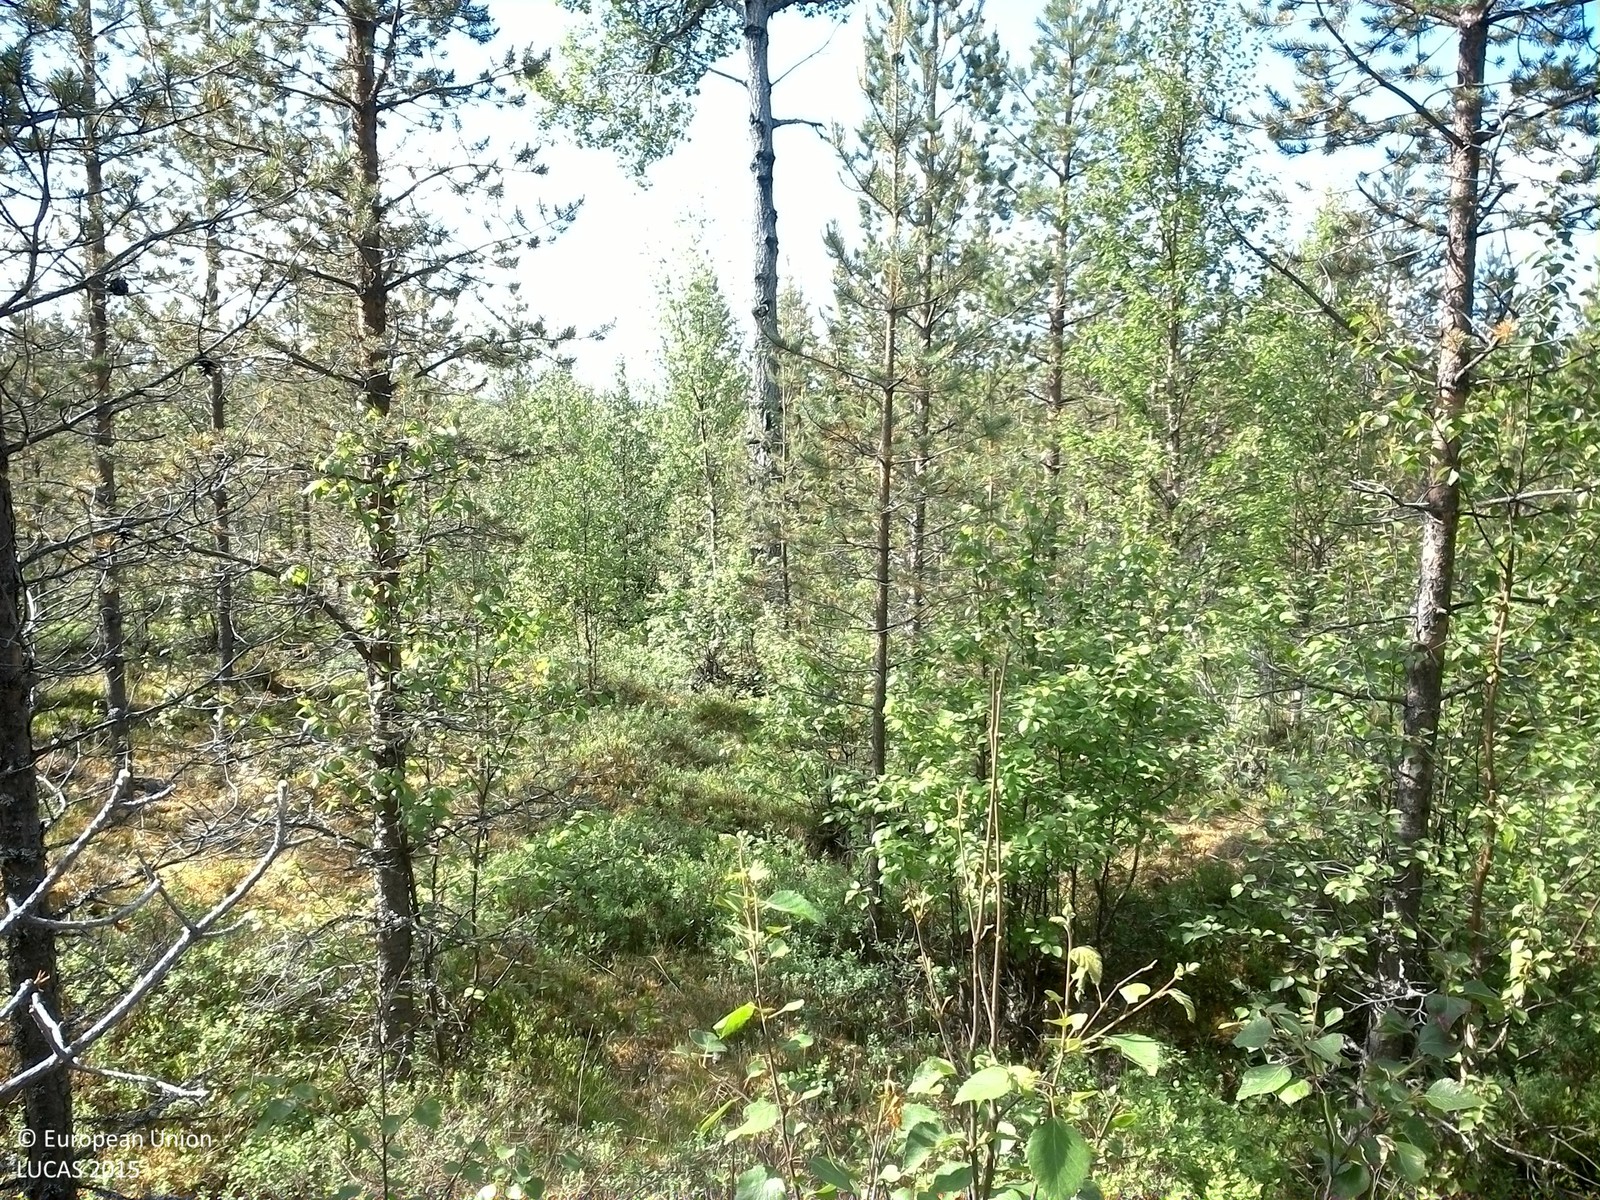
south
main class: Woodland
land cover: Pine dominated mixed woodland
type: boreal forest
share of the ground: 50 - 75 %
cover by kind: coniferous forest trees 40 %, shrubs 20 %, broadleaved forest trees 15 %, herbaceous plants 10 %, lichens and mosses 10 %, consolidated bare surface 5 %
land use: Forestry
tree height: < 5 m
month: July
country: SE
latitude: 64.3225
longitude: 16.8565
